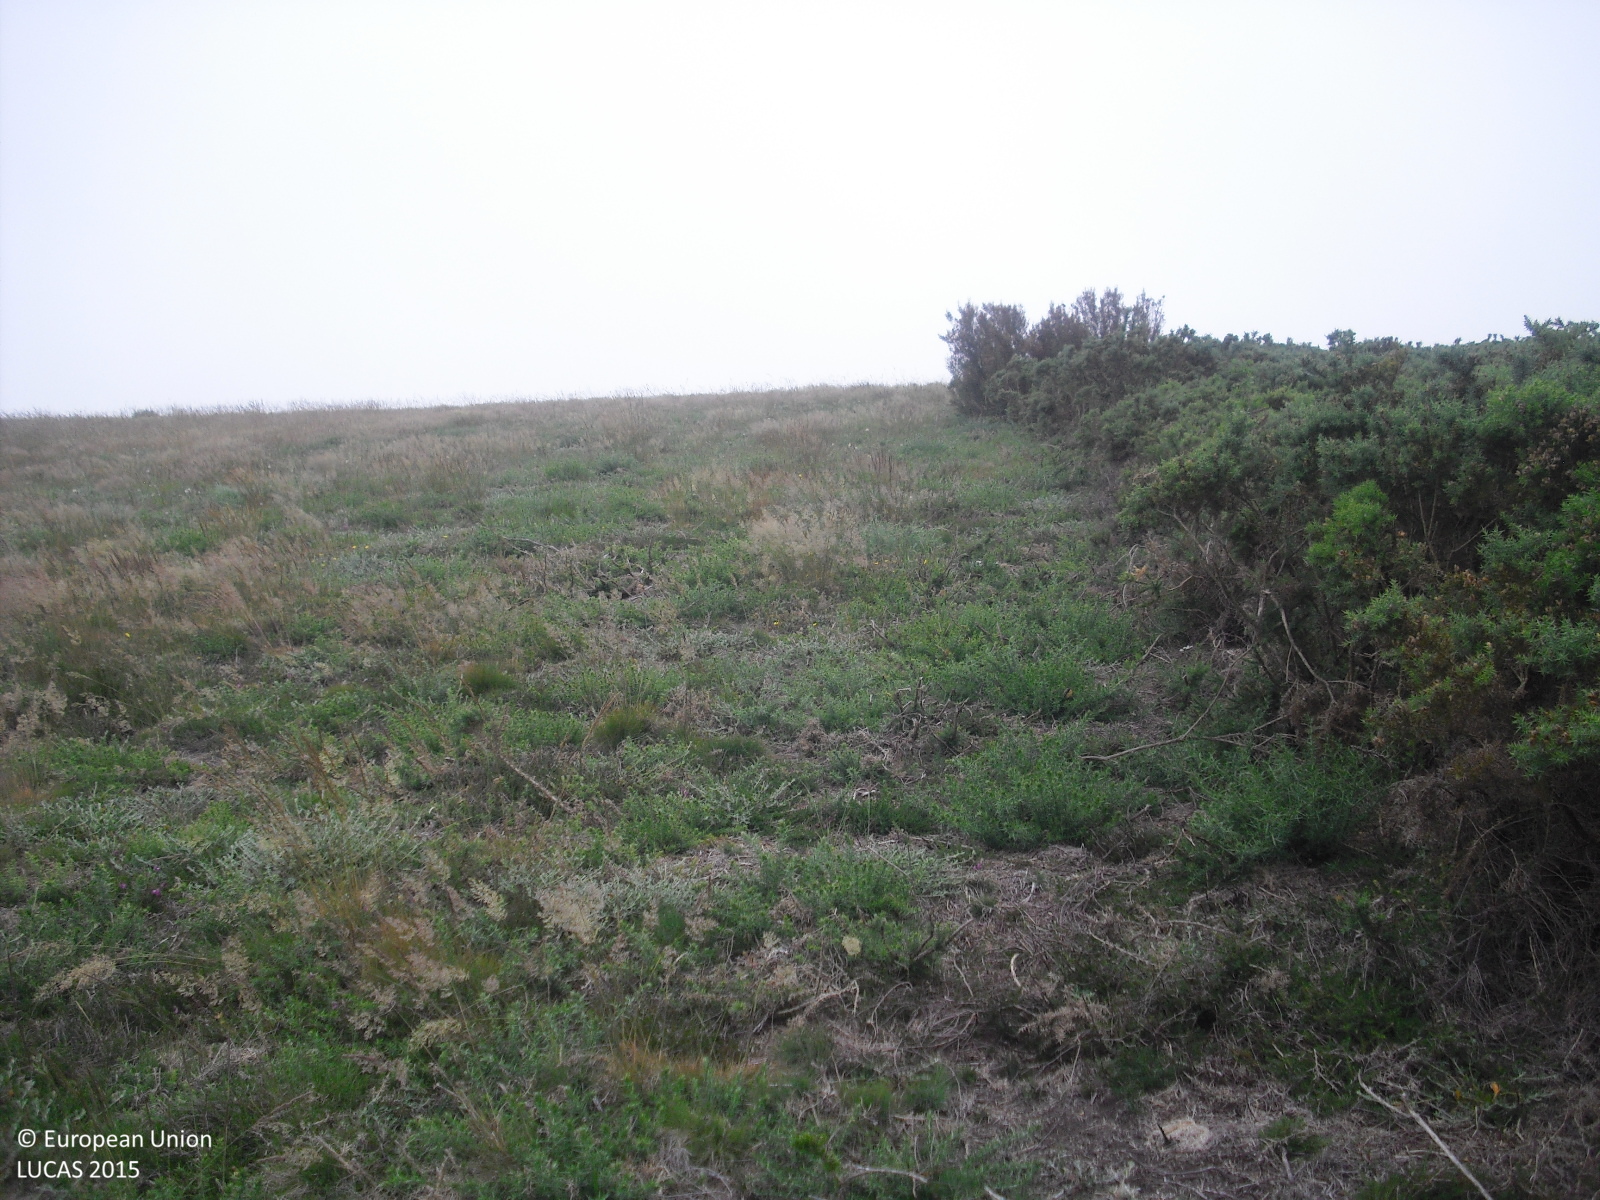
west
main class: Shrubland
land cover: Shrubland without tree cover
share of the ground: > 75 %
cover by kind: shrubs 100 %
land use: Semi-natural and natural areas not in use
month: June
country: ES
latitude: 42.7097
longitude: -7.8714
